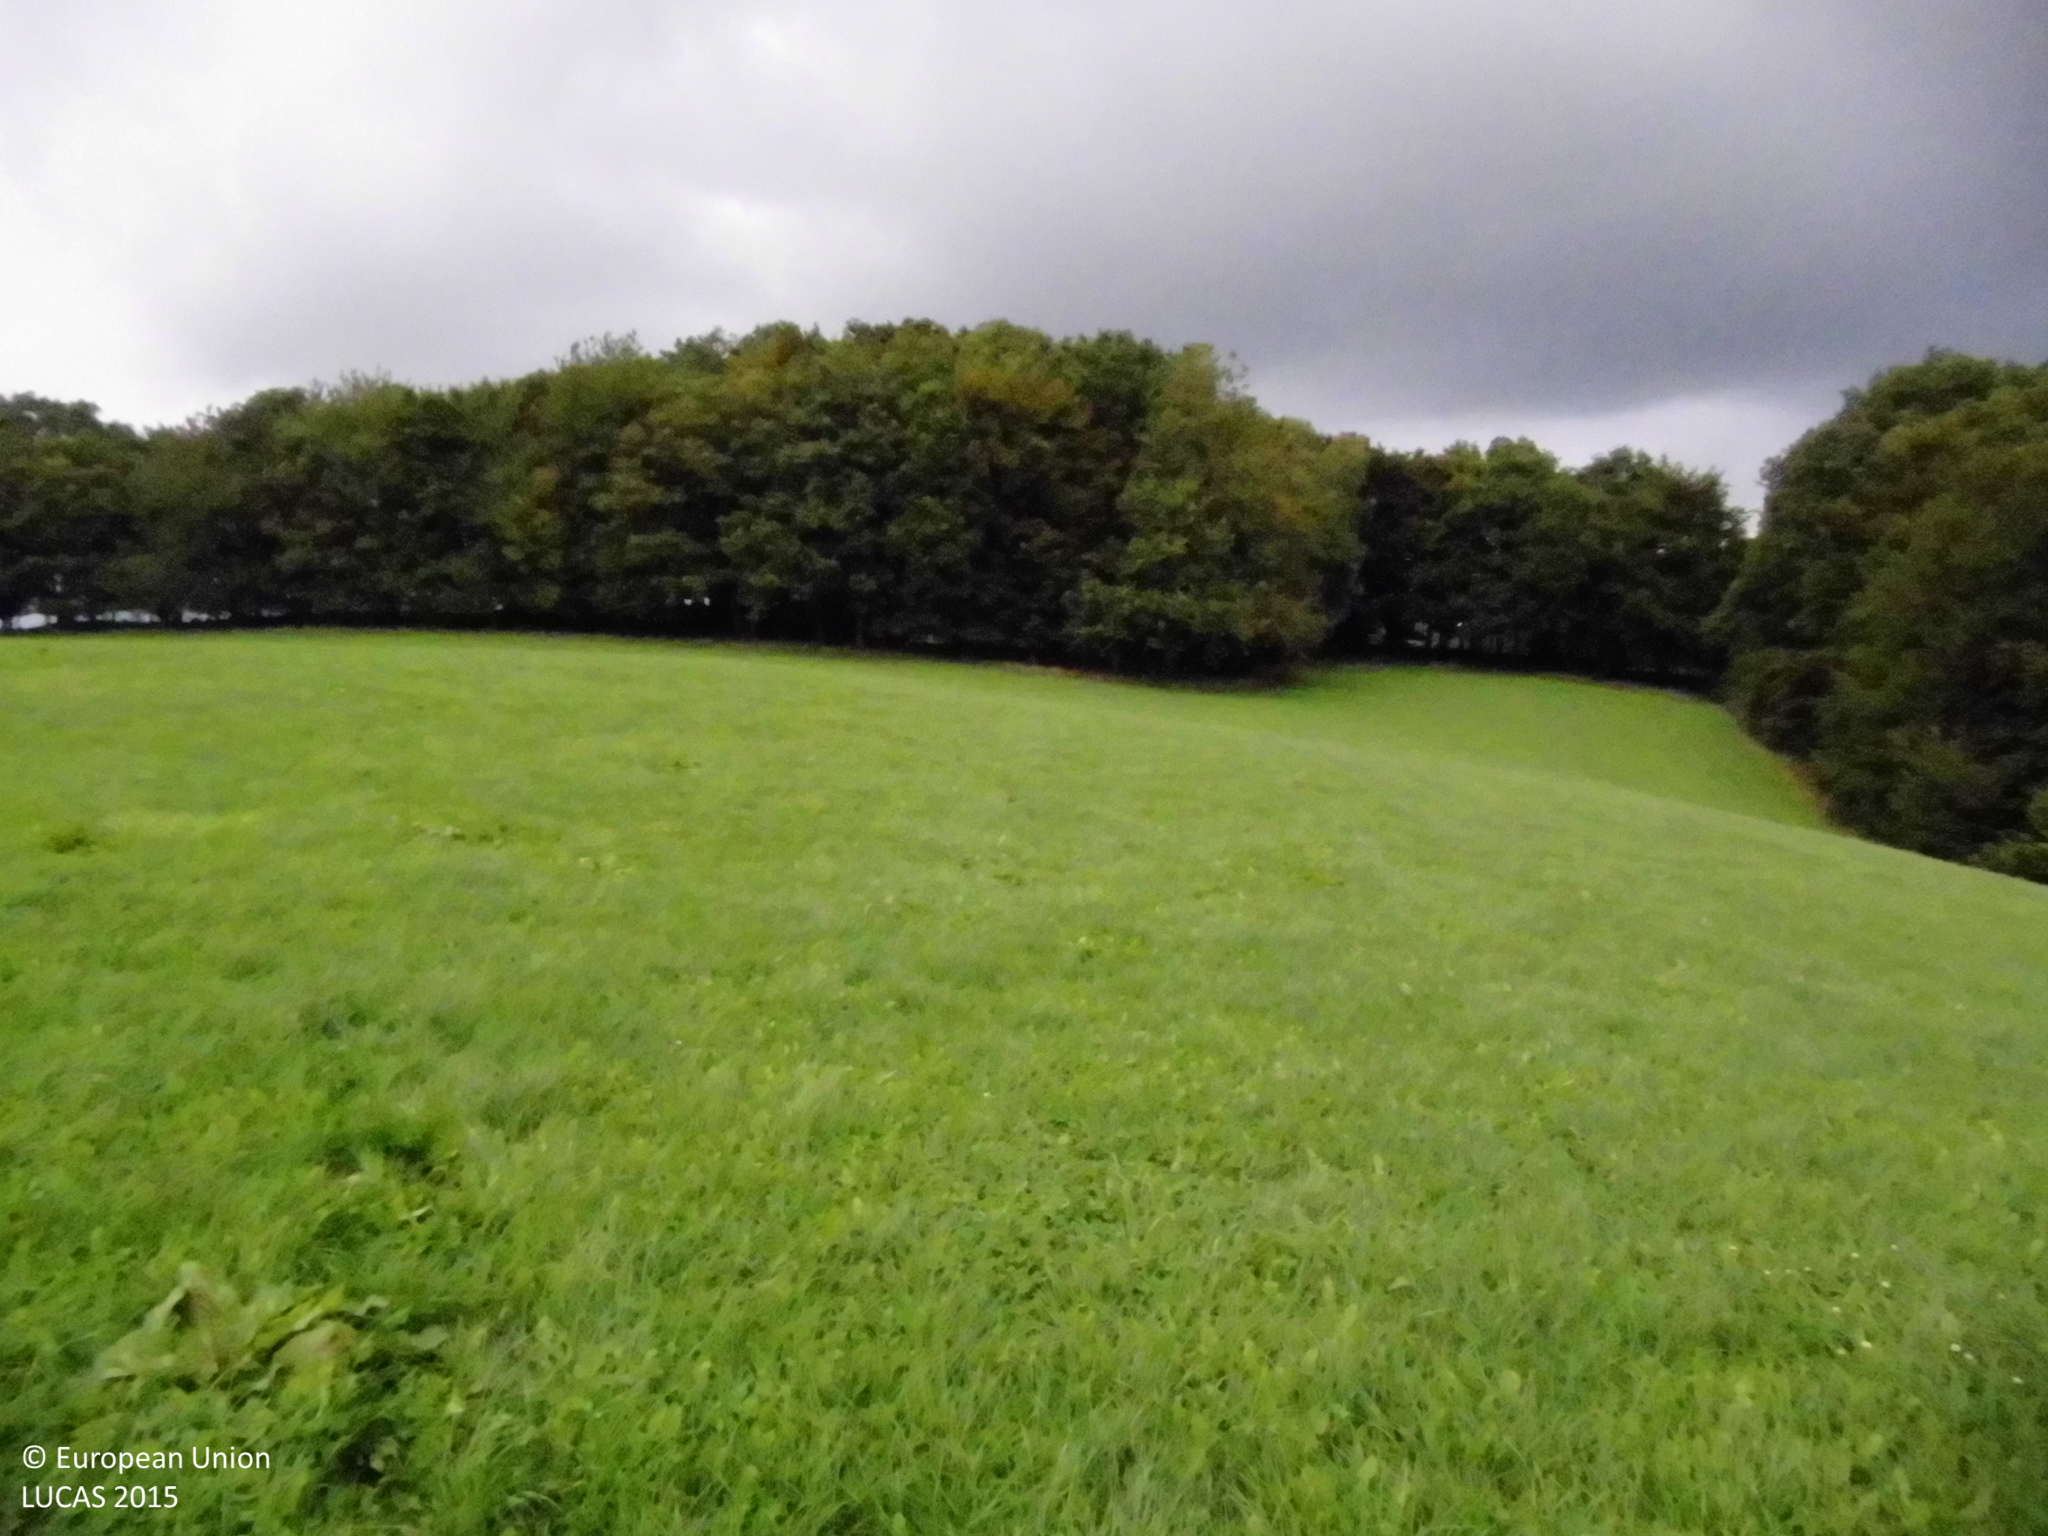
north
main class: Grassland
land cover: Grassland without tree/shrub cover
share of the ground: > 75 %
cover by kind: herbaceous plants 100 %
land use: Agriculture (excluding fallow land and kitchen gardens)
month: September
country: DE
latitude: 50.5514
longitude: 7.4456
